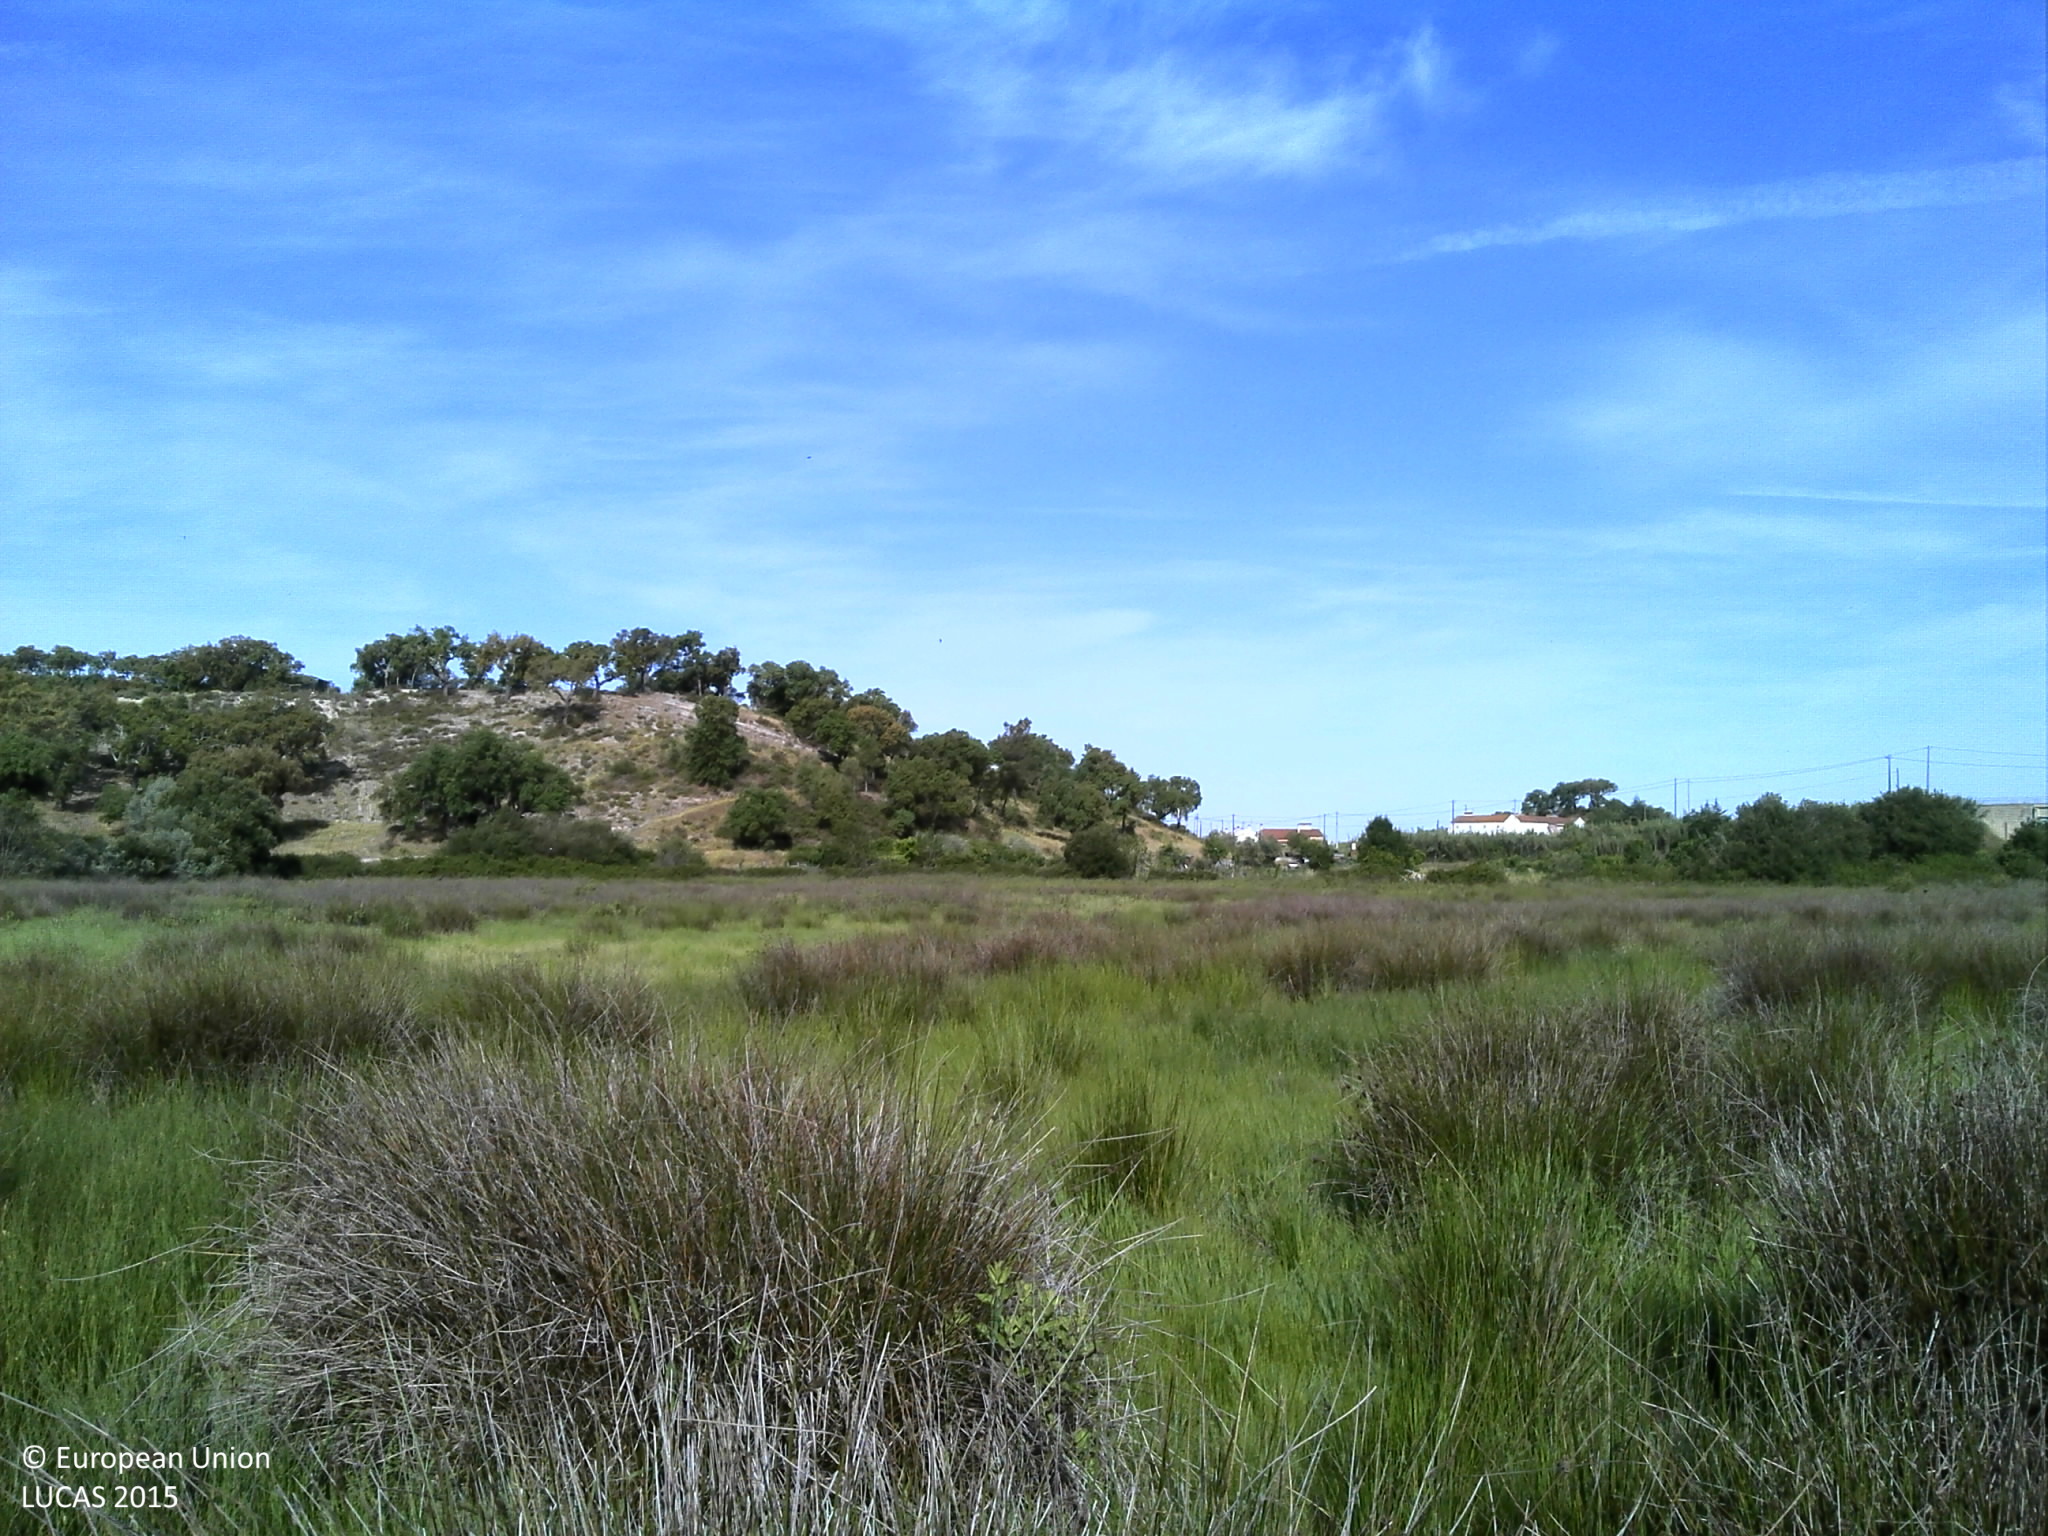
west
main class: Grassland
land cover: Grassland without tree/shrub cover
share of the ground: > 75 %
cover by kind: herbaceous plants 80 %, unconsolidated bare surface 20 %
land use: Agriculture (excluding fallow land and kitchen gardens)
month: May
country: PT
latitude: 39.3079
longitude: -7.9011
